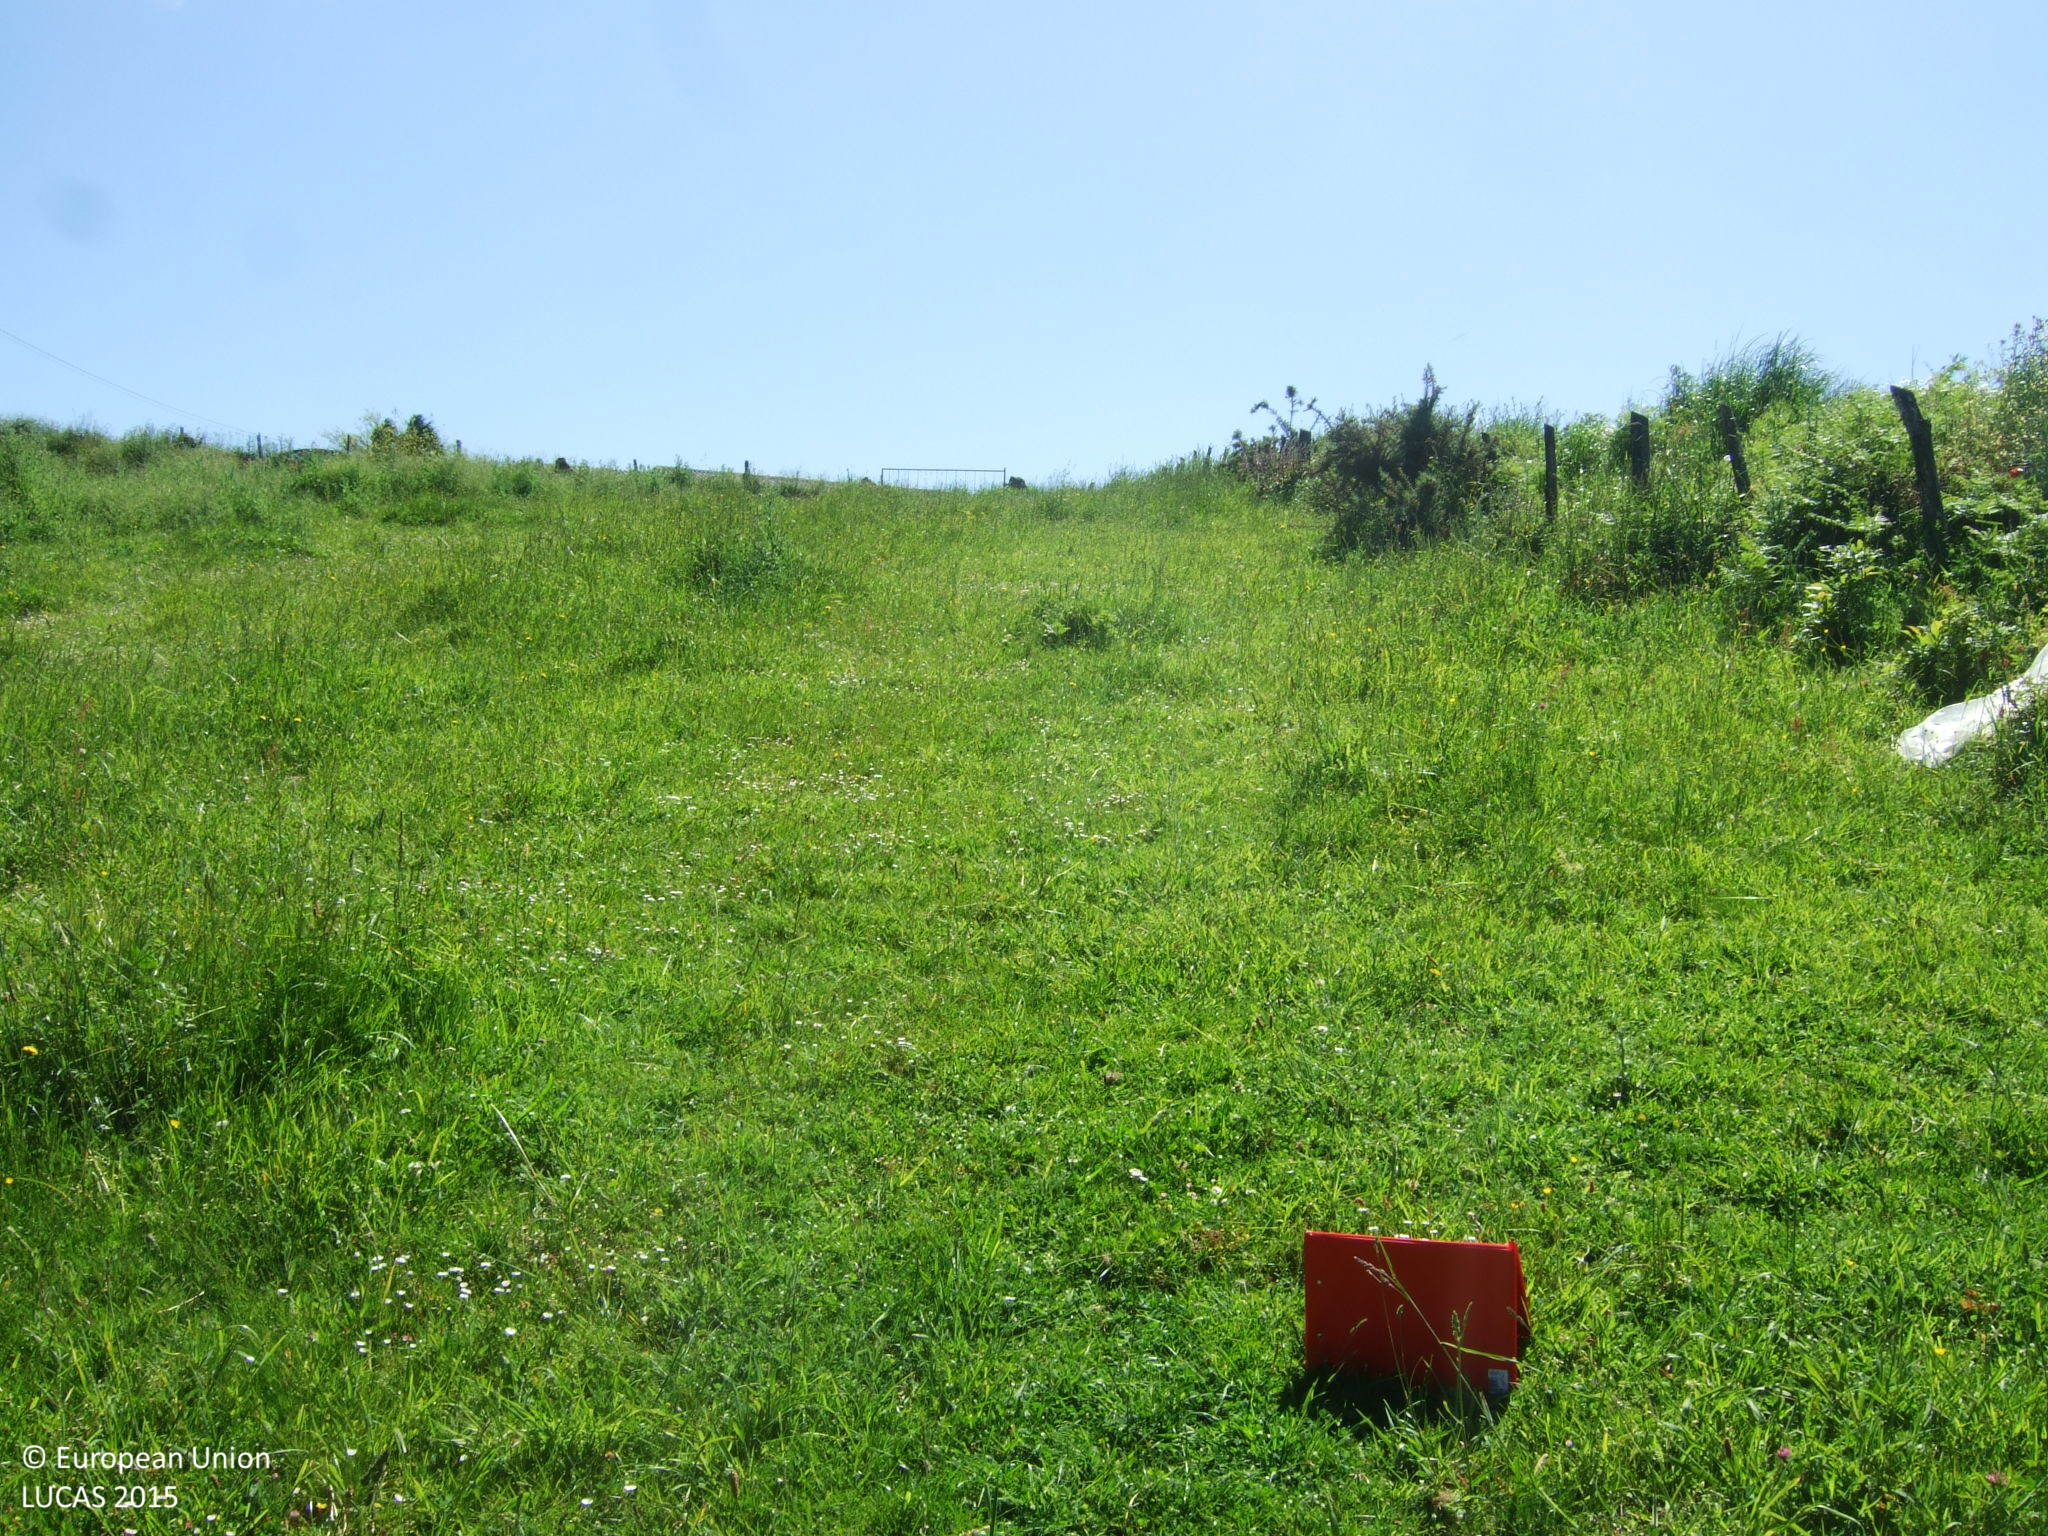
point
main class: Grassland
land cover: Grassland without tree/shrub cover
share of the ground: > 75 %
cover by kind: herbaceous plants 100 %
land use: Agriculture (excluding fallow land and kitchen gardens)
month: May
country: ES
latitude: 42.7430
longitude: -7.5799
